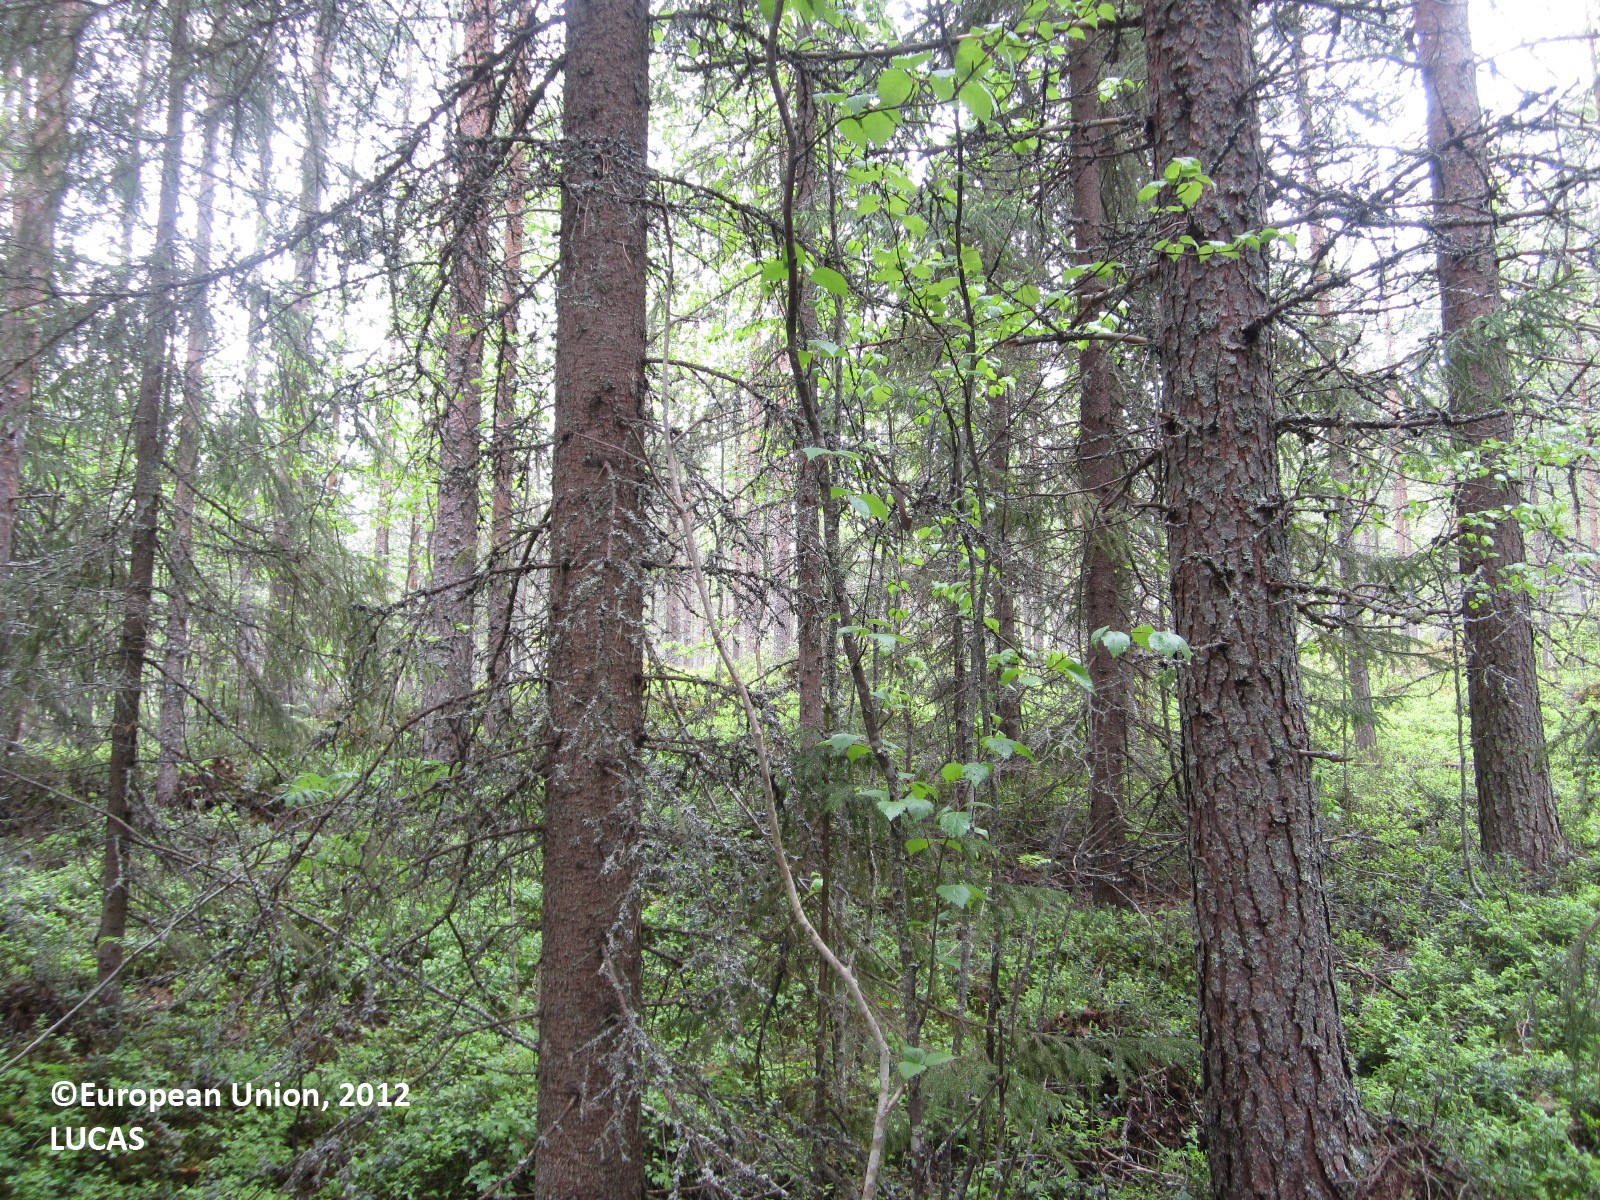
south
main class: Woodland
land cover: Pine dominated mixed woodland
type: boreal forest
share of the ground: > 75 %
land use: Forestry
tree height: > 5 m
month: June
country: FI
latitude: 64.6172
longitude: 28.6846
